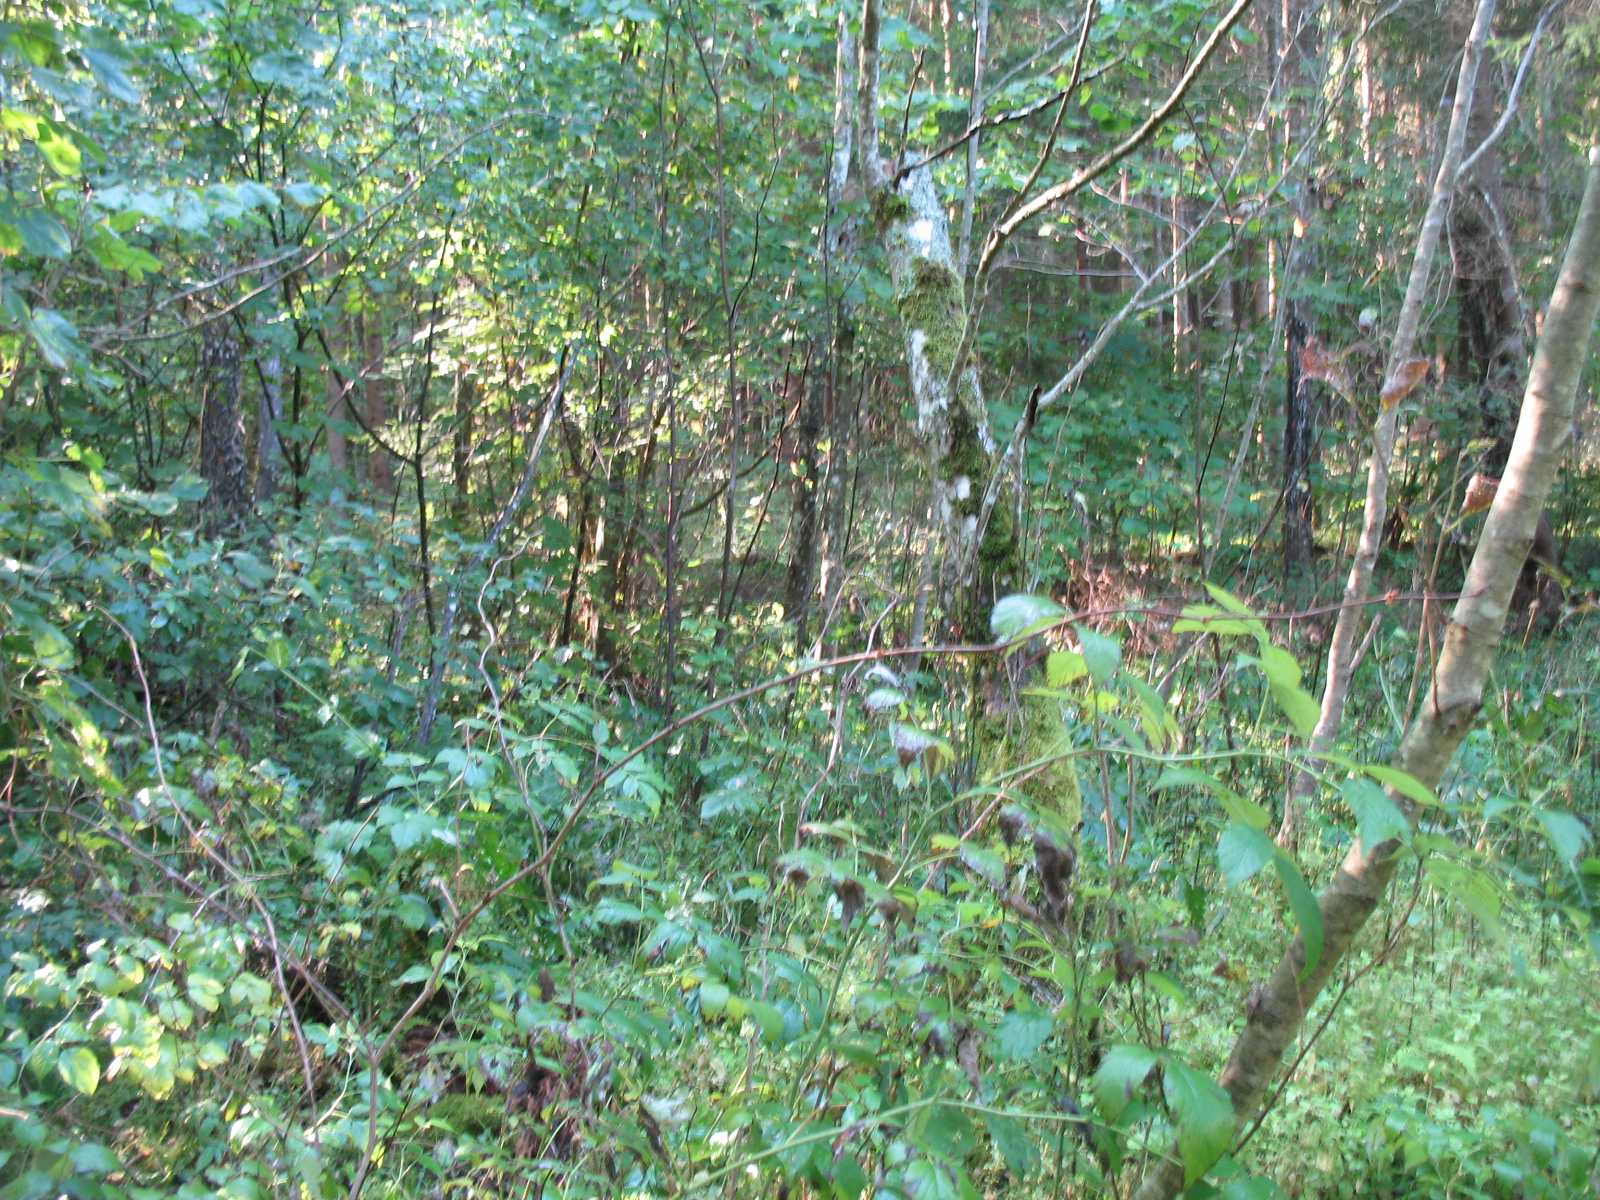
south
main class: Woodland
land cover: Broadleaved woodland
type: non-riverine alder, birch or aspen forest
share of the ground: 50 - 75 %
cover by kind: broadleaved forest trees 55 %, herbaceous plants 40 %, shrubs 5 %
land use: Forestry
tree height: > 5 m
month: September
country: LV
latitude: 56.1904
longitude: 25.5109
